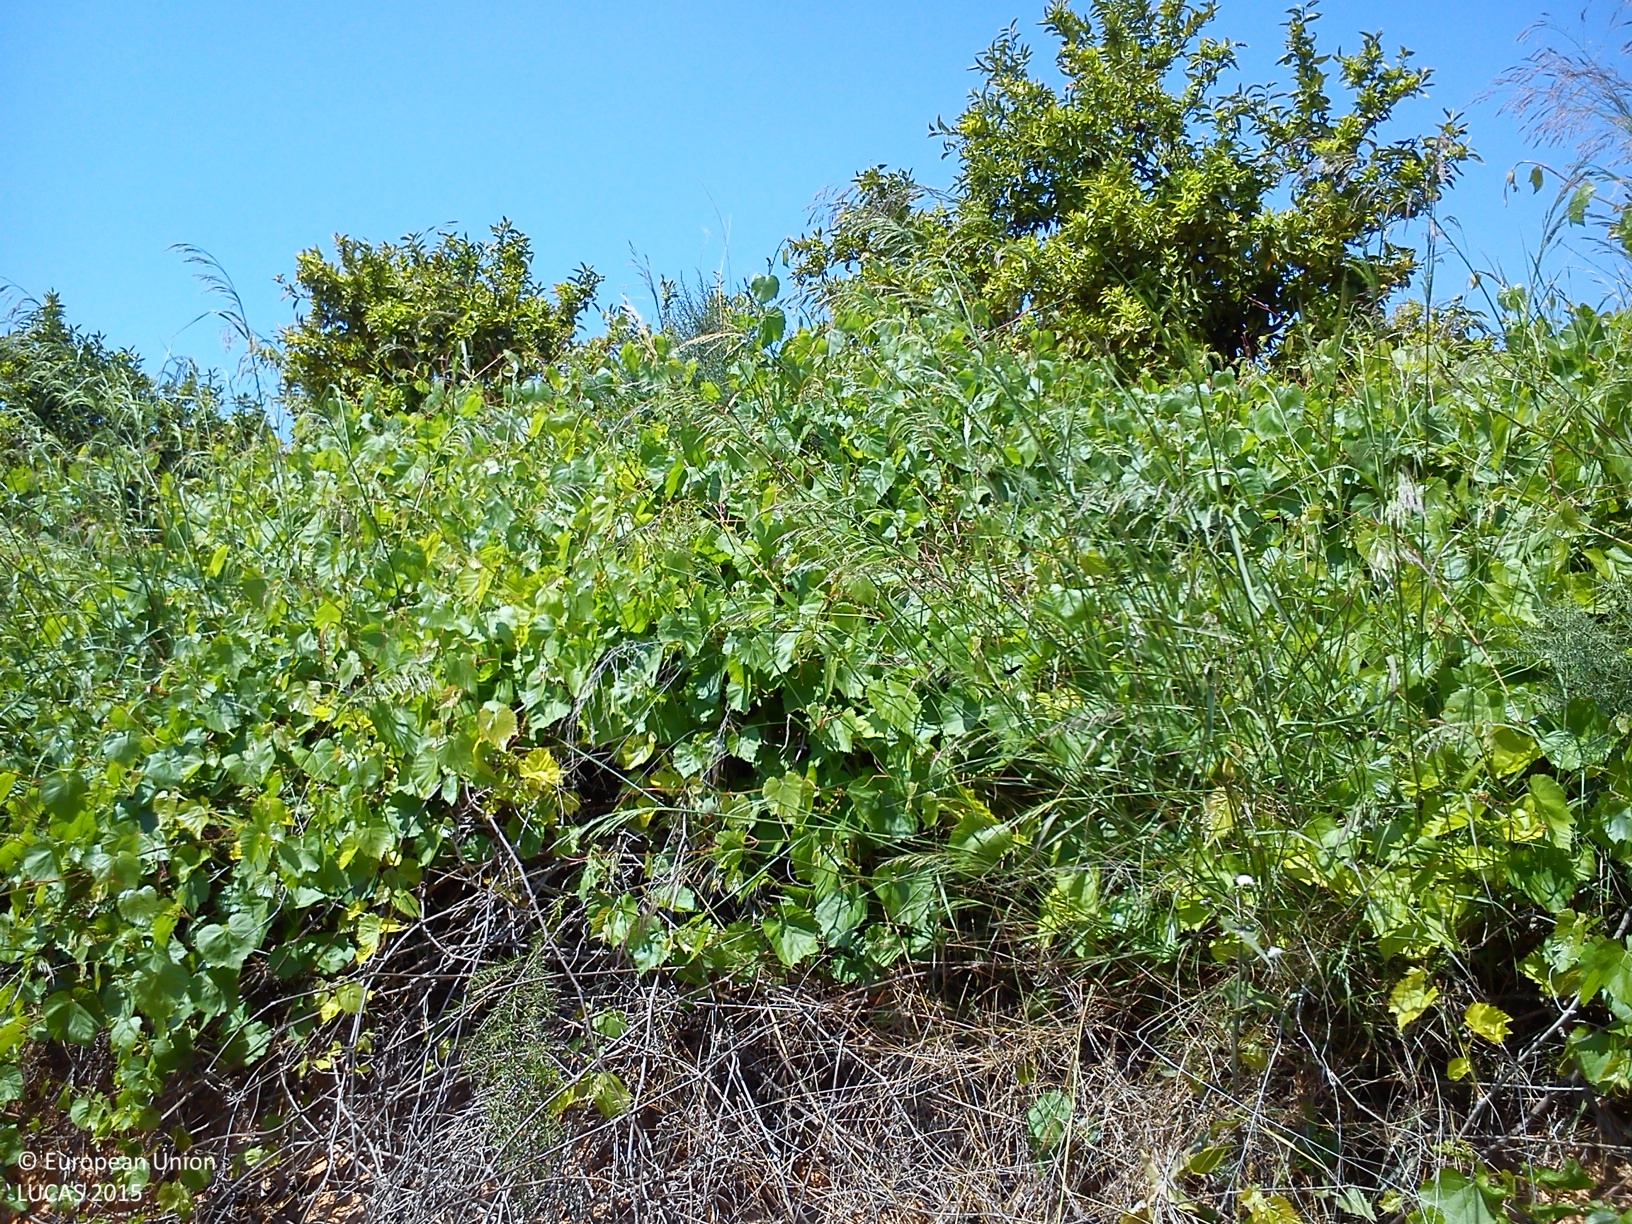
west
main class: Cropland
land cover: Oranges
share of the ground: 50 - 75 %
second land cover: Spontaneously vegetated surfaces
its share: < 10 %
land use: Agriculture (excluding fallow land and kitchen gardens)
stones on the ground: 10 - 25 %
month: April
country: ES
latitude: 39.6250
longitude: -0.7067
